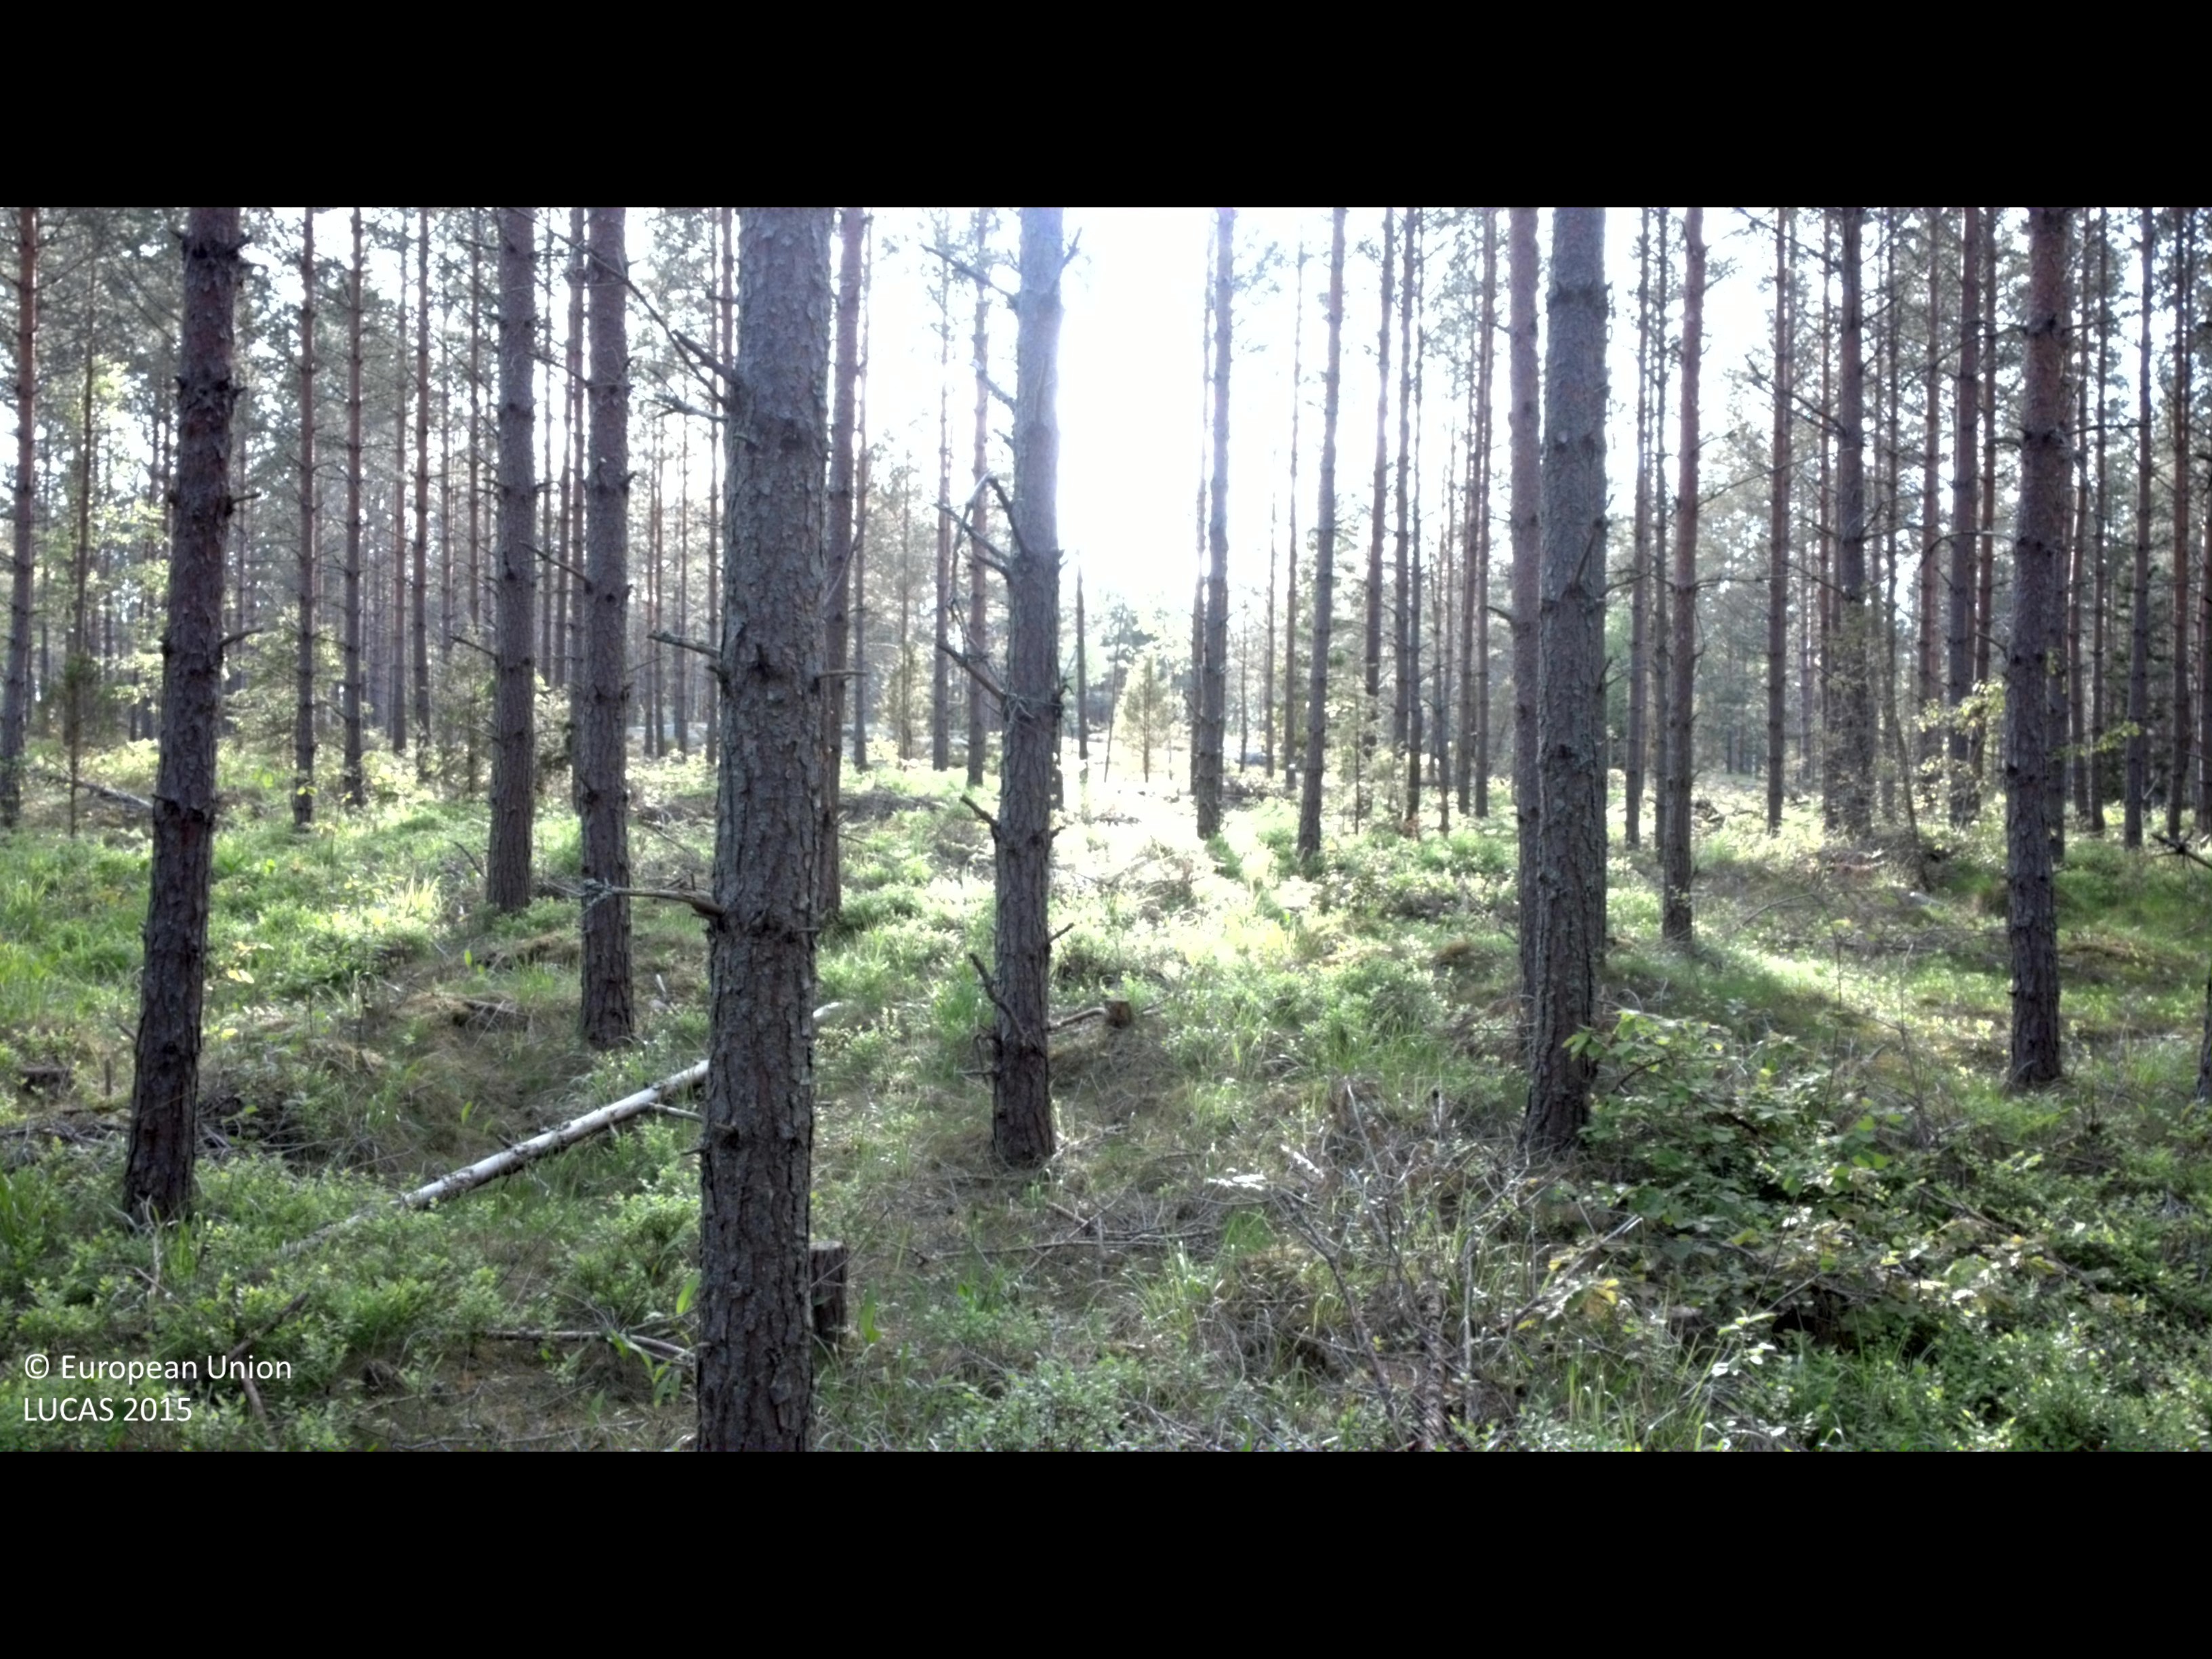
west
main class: Woodland
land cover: Pine dominated coniferous woodland
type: boreal forest
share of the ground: 50 - 75 %
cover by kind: coniferous forest trees 65 %, shrubs 30 %, herbaceous plants 5 %
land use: Forestry
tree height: > 5 m
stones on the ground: 10 - 25 %
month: June
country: SE
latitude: 57.6054
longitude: 16.2405
